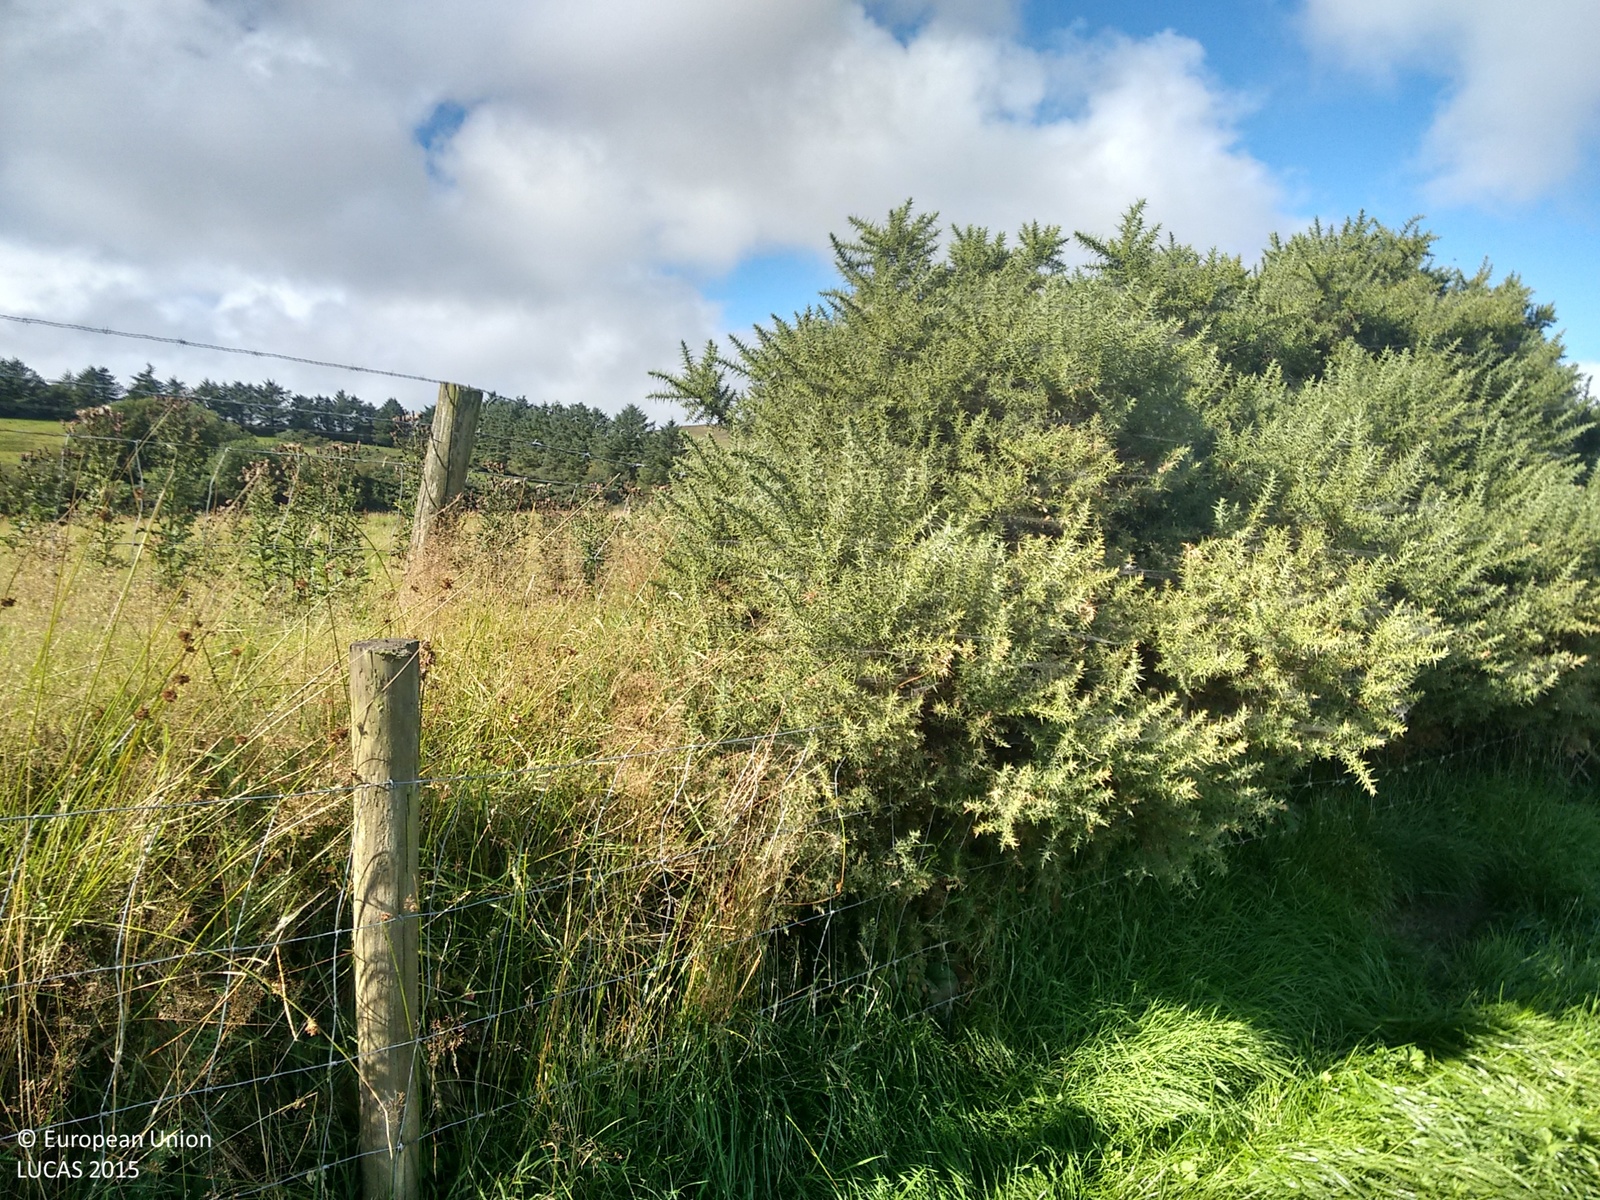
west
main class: Grassland
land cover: Grassland without tree/shrub cover
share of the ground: > 75 %
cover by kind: herbaceous plants 100 %
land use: Agriculture (excluding fallow land and kitchen gardens)
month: September
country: IE
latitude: 55.1379
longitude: -7.2276
